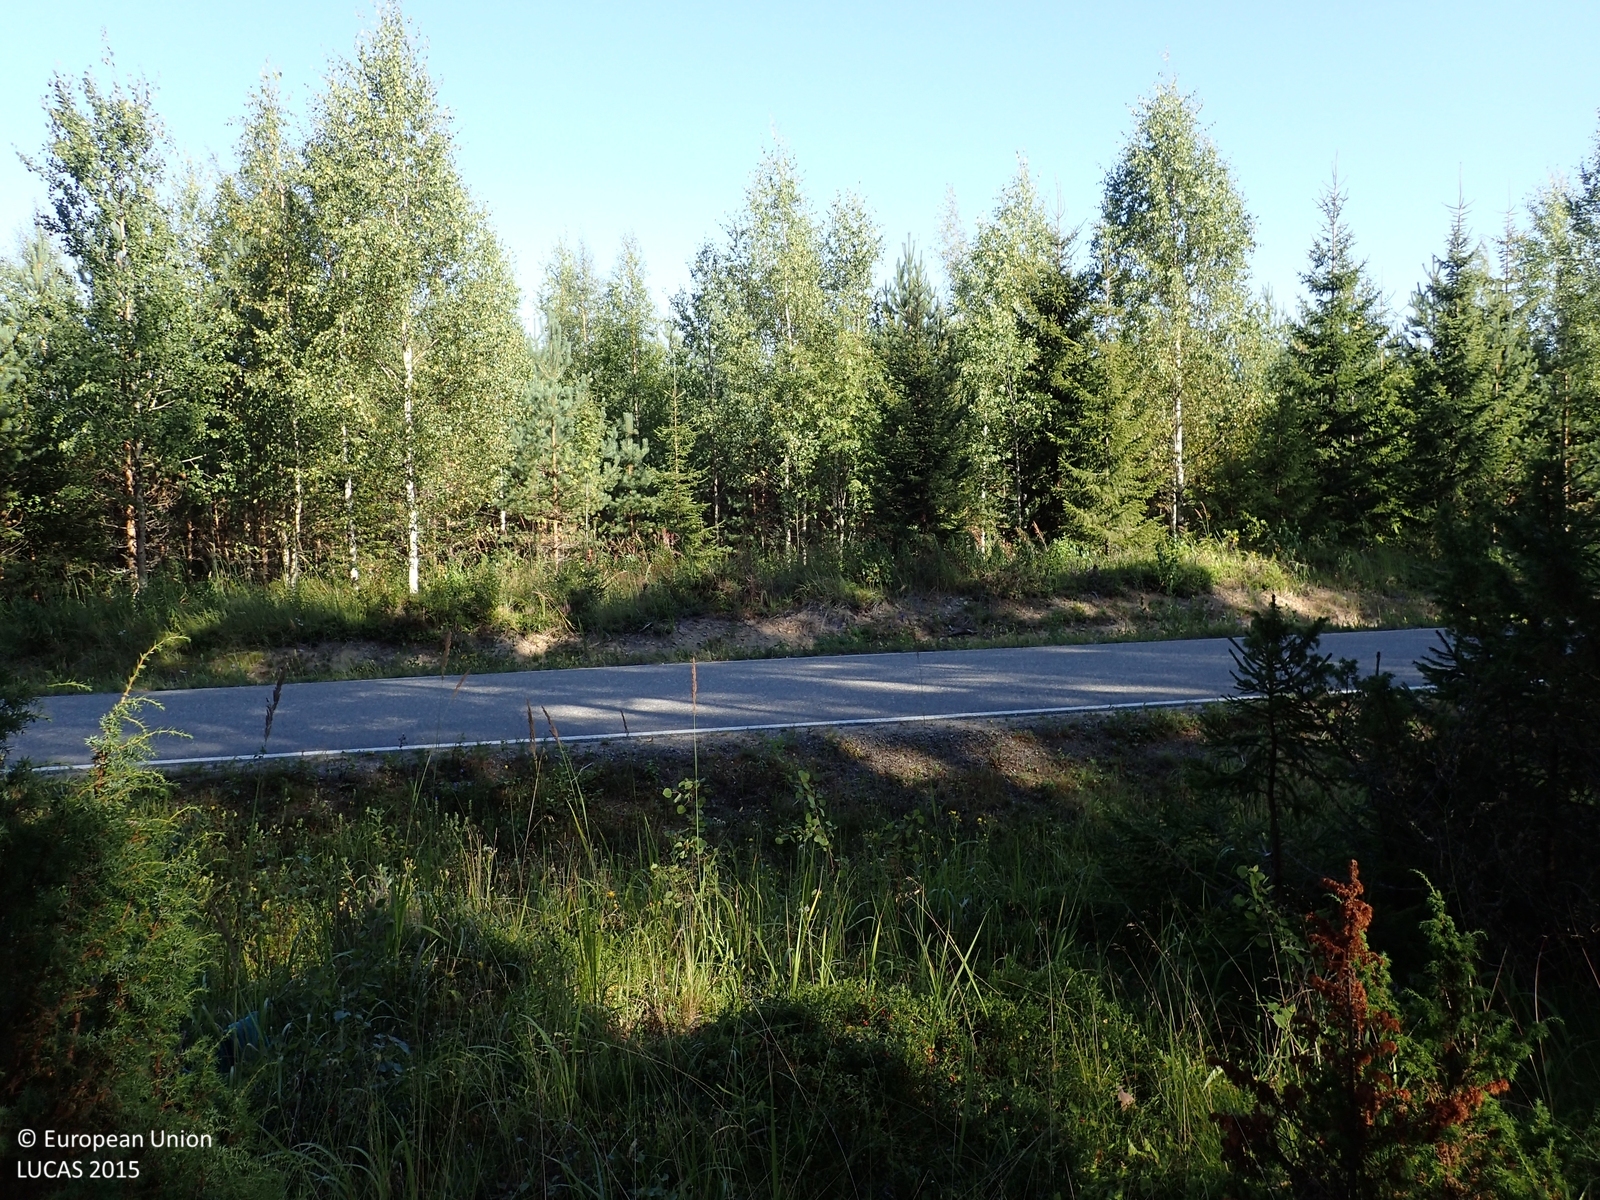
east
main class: Woodland
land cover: Pine dominated coniferous woodland
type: boreal forest
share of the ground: > 75 %
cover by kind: coniferous forest trees 75 %, shrubs 20 %, herbaceous plants 5 %
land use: Forestry
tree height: > 5 m
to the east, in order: Pine dominated coniferous woodland; Ditches and canals; Grass margins; Paved roads, cycling and walking lanes; Grass margins; Ditches and canals; Pine dominated mixed woodland; Ditches and canals; Broadleaved woodland; Ditches and canals; Broadleaved woodland; Ditches and canals; Broadleaved woodland; Ditches and canals; Broadleaved woodland; Ditches and canals; Broadleaved woodland; Ditches and canals; Spruce dominated mixed woodland; Broadleaved woodland; Ditches and canals; Broadleaved woodland; Other mixed woodland; Ditches and canals; Pine dominated mixed woodland
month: August
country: FI
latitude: 62.4384
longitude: 21.8065
